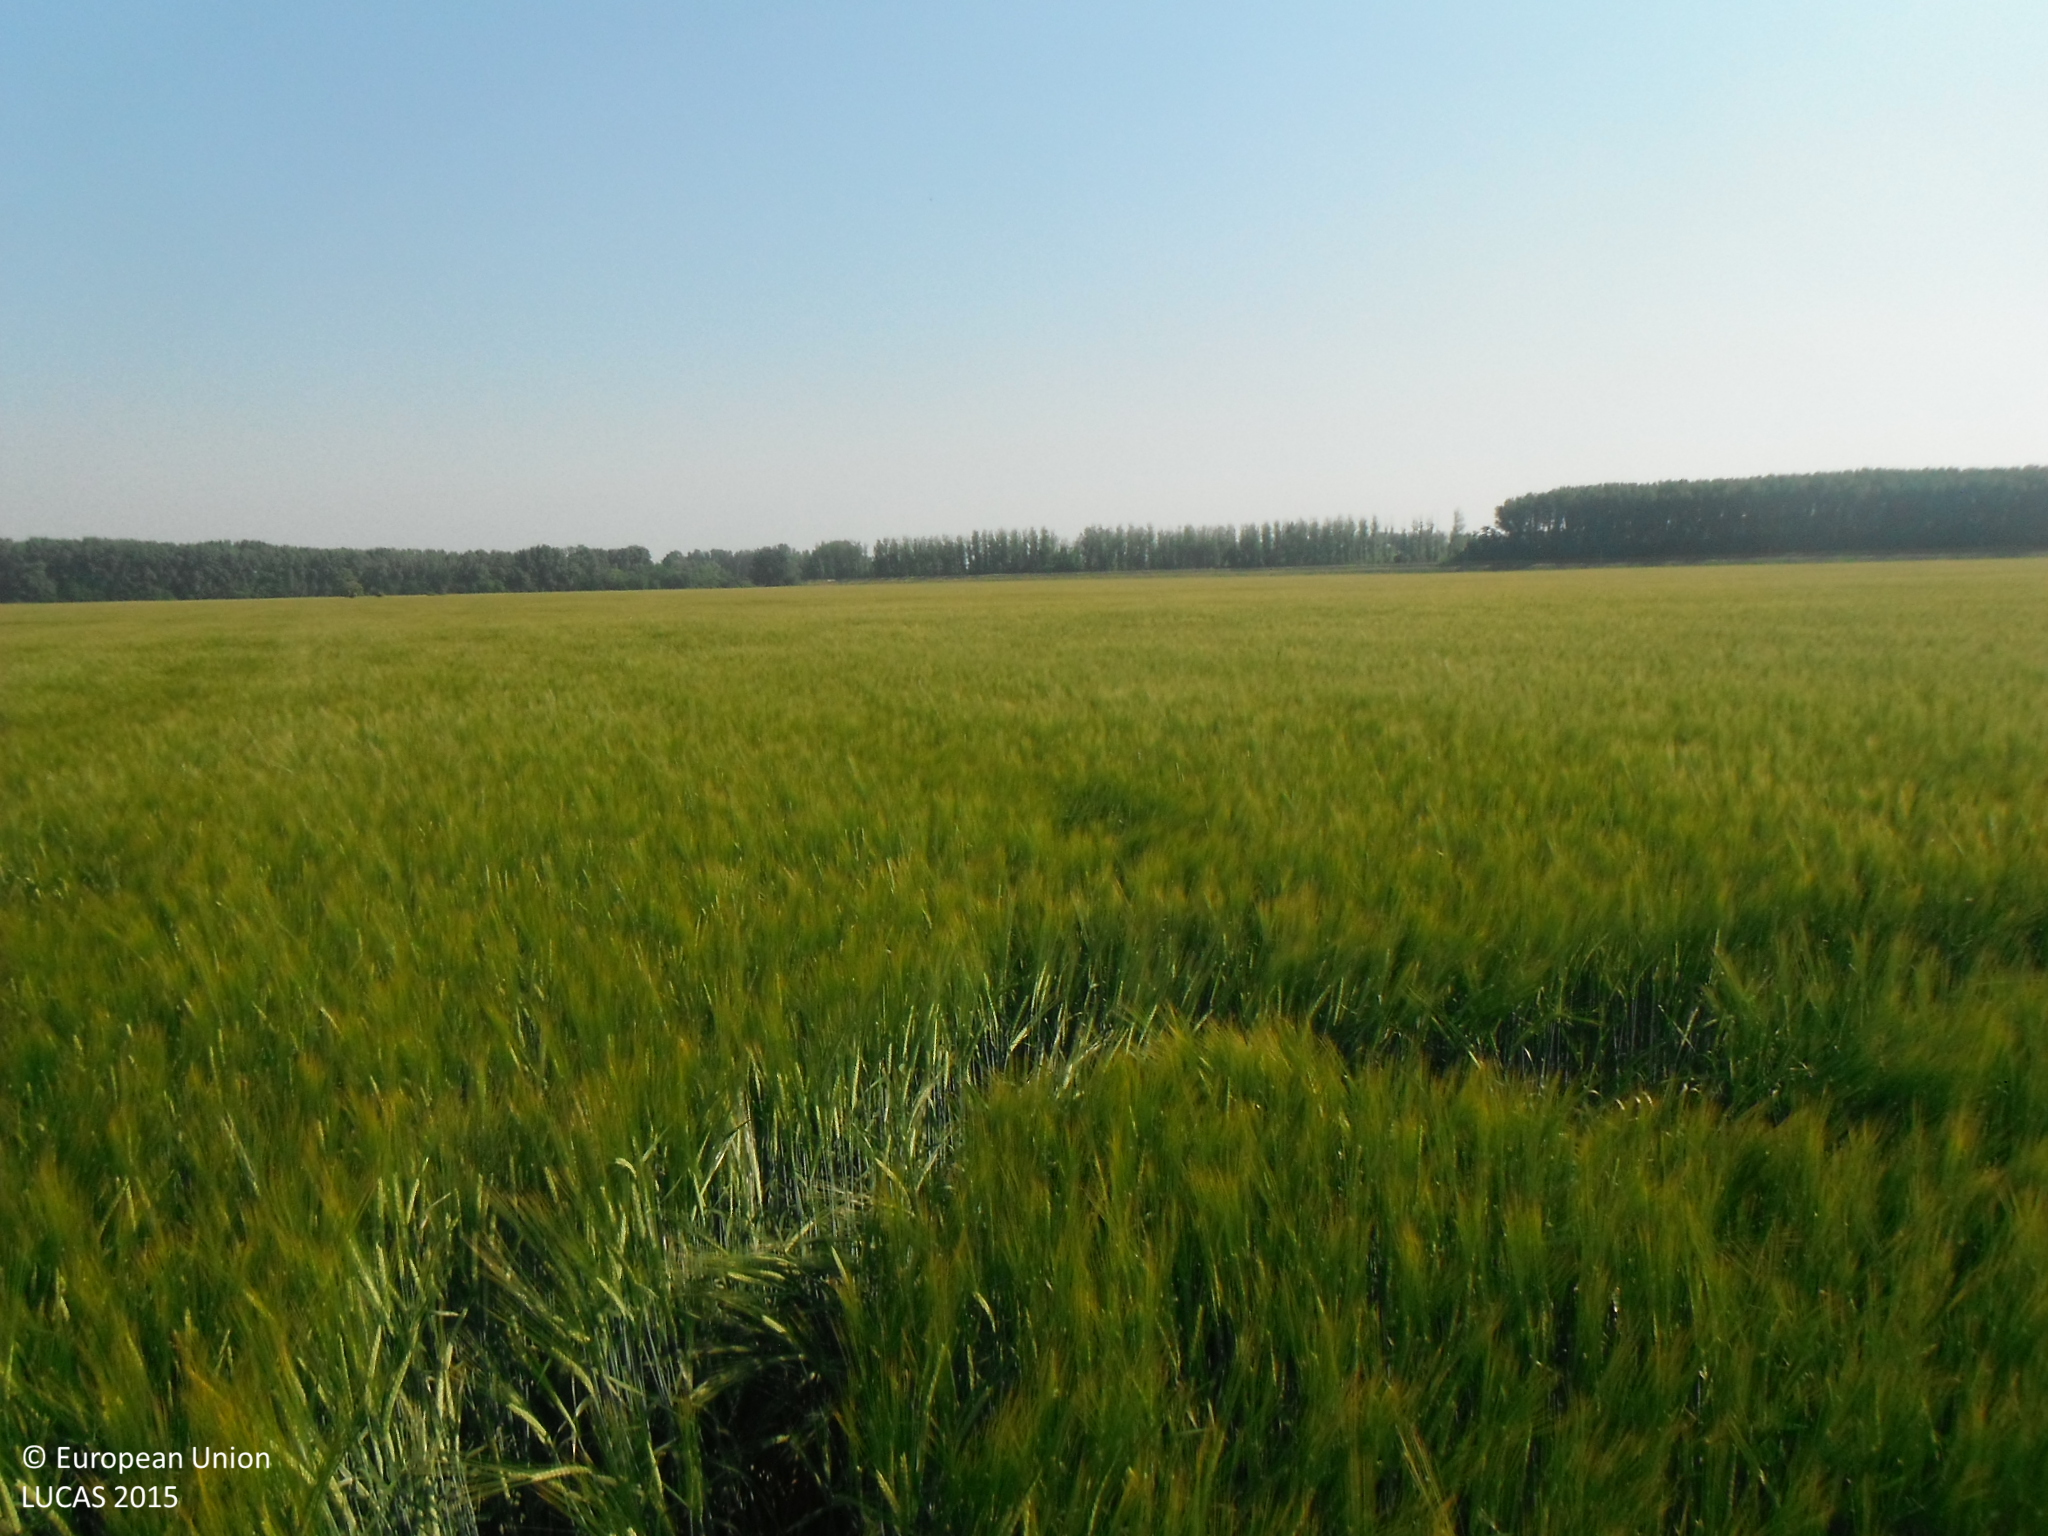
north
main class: Cropland
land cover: Barley
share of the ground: > 75 %
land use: Agriculture (excluding fallow land and kitchen gardens)
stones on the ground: < 10 %
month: June
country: SK
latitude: 48.1386
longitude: 17.9005
